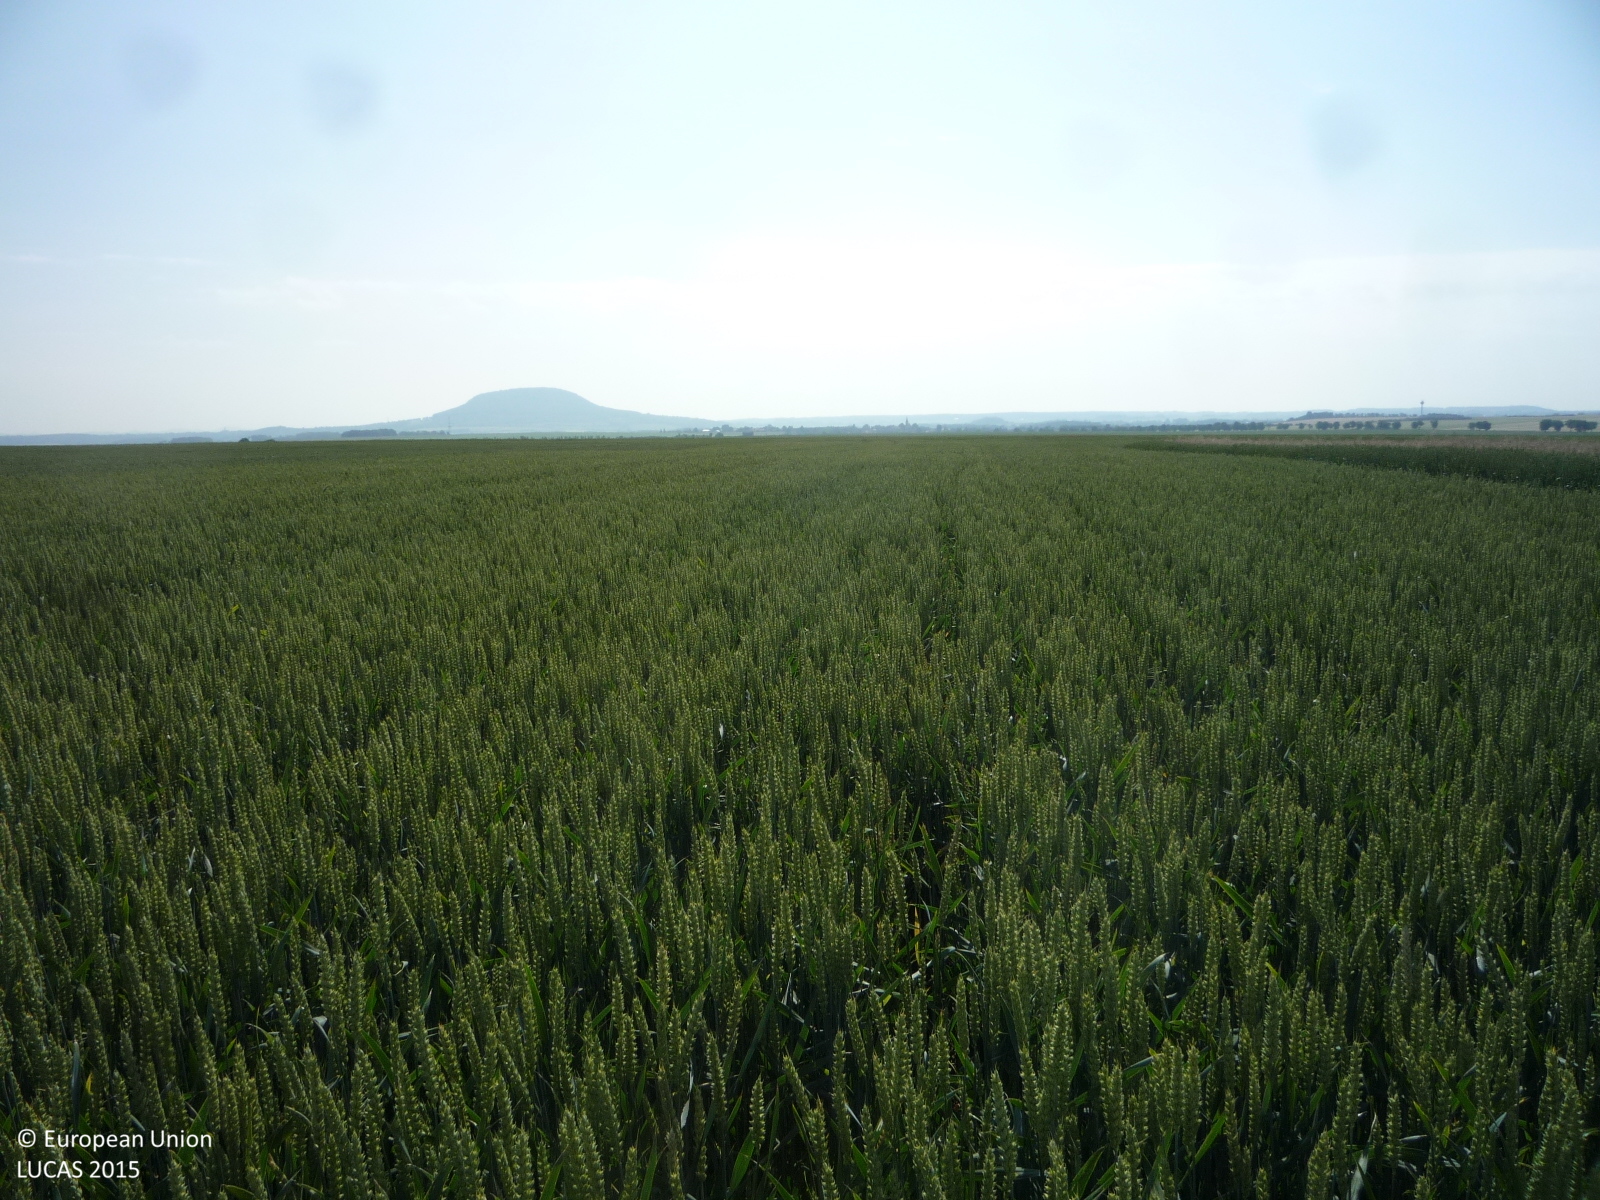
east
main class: Cropland
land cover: Common wheat
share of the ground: > 75 %
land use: Agriculture (excluding fallow land and kitchen gardens)
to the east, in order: Common wheat
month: June
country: CZ
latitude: 50.3778
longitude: 14.1776
